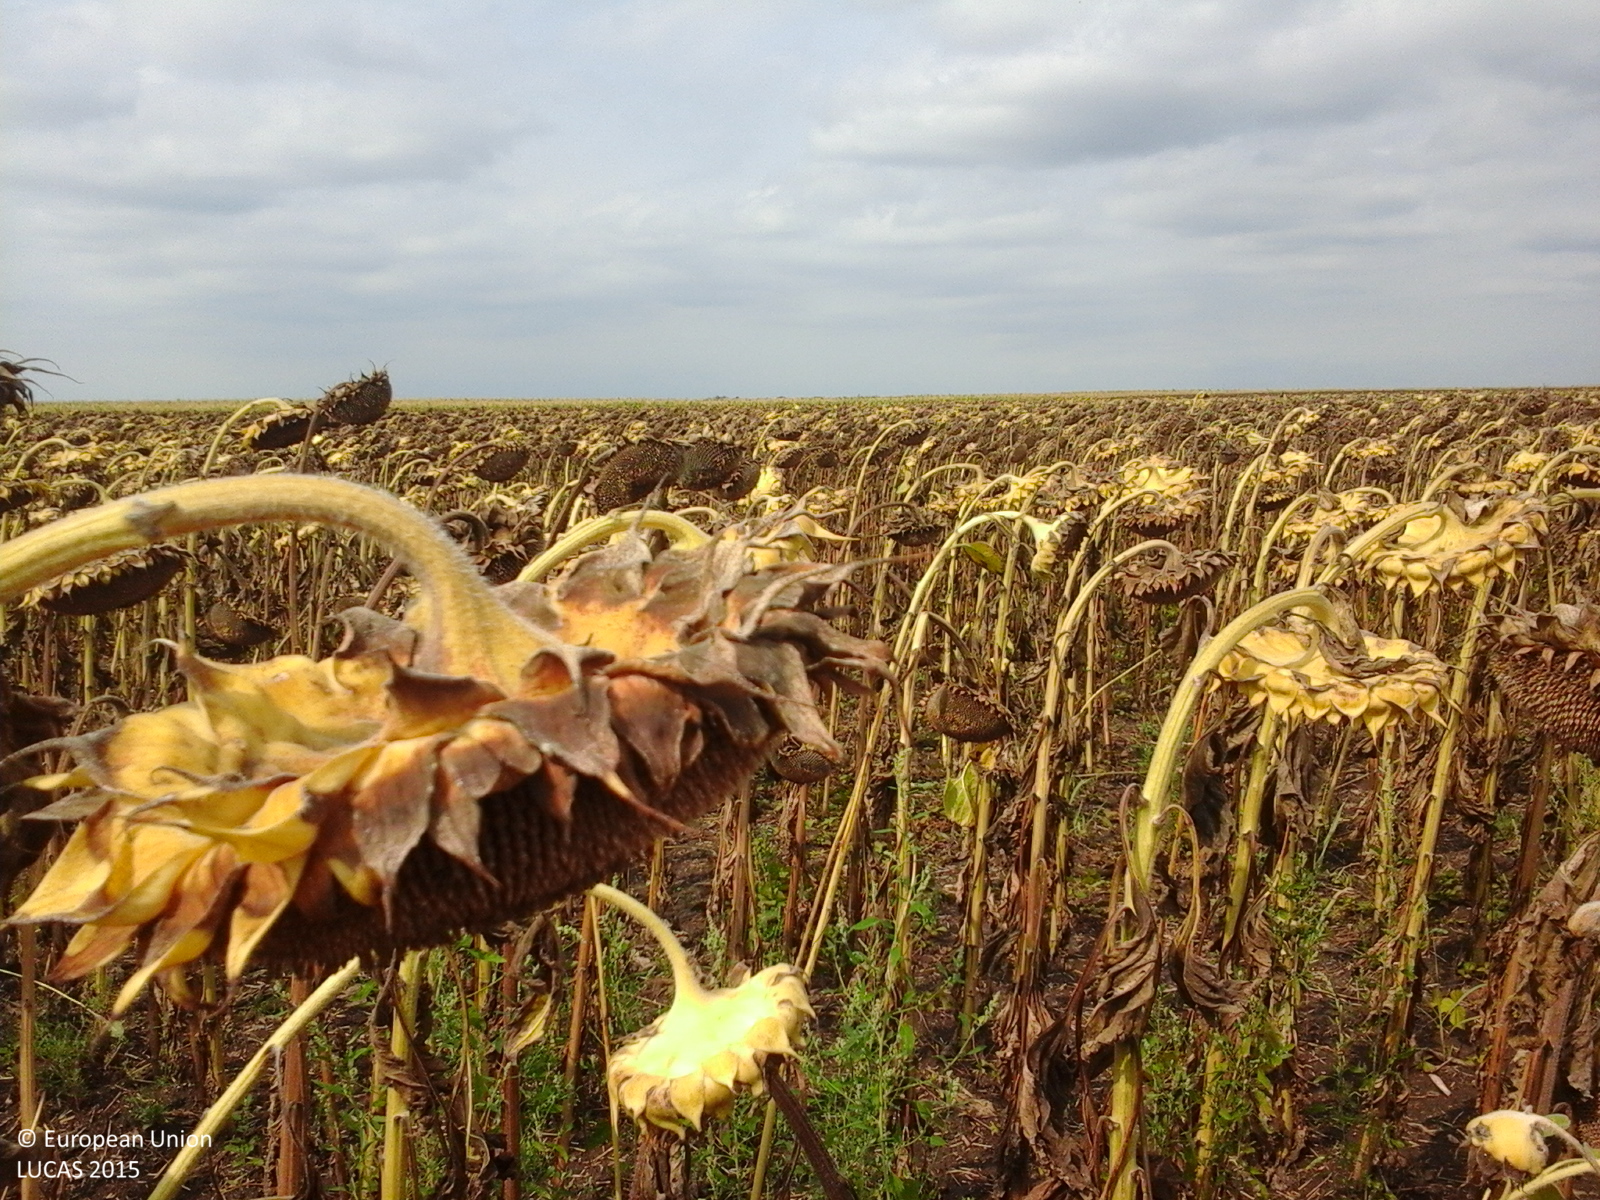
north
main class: Cropland
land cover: Sunflower
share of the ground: > 75 %
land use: Agriculture (excluding fallow land and kitchen gardens)
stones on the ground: < 10 %
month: August
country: RO
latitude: 45.4796
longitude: 20.9383
